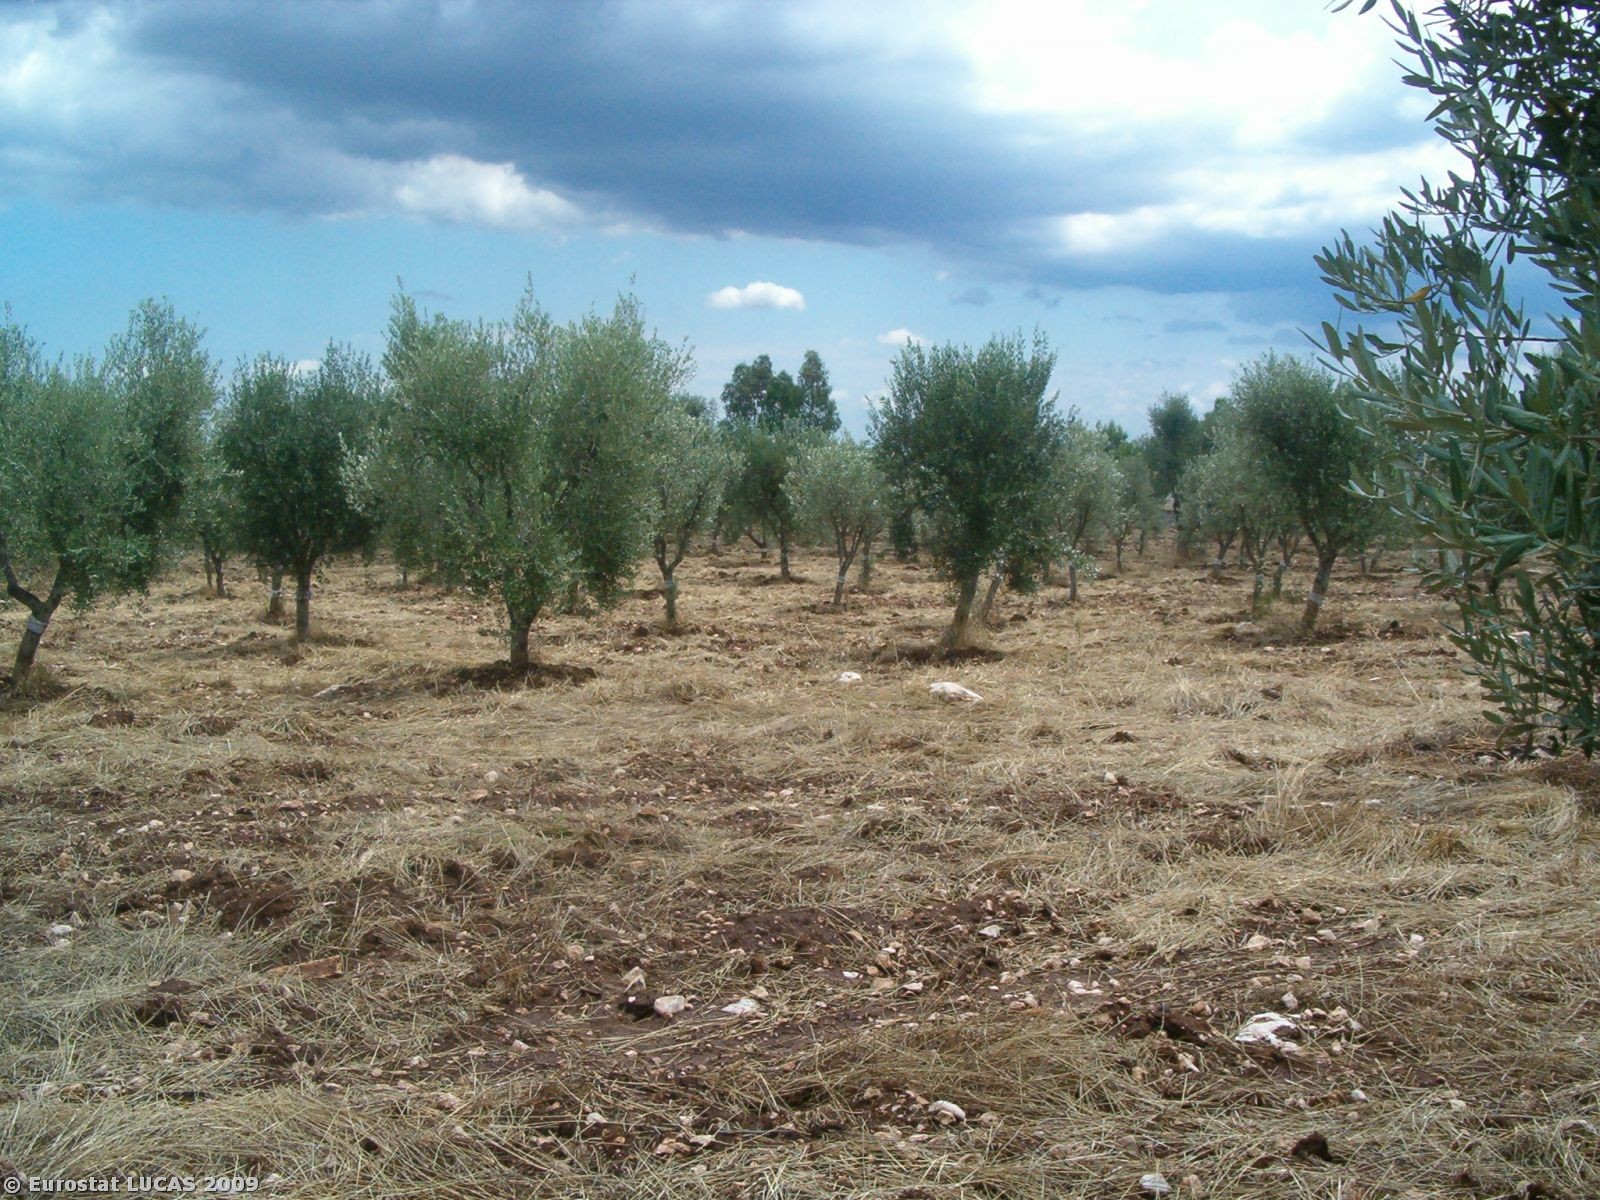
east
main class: Cropland
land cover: Olive groves
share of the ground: 50 - 75 %
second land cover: Grassland with sparse tree/shrub cover
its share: 50 - 75 %
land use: Agriculture (excluding fallow land and kitchen gardens)
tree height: < 5 m
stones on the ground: 25 - 50 %
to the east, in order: Olive groves; Grassland with sparse tree/shrub cover; Abandoned hedges; Dry stone walls; Abandoned hedges; Olive groves; Bare land; Tracks; Grass margins; Mixed cereals for fodder
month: June
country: IT
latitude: 40.4875
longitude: 17.5144
